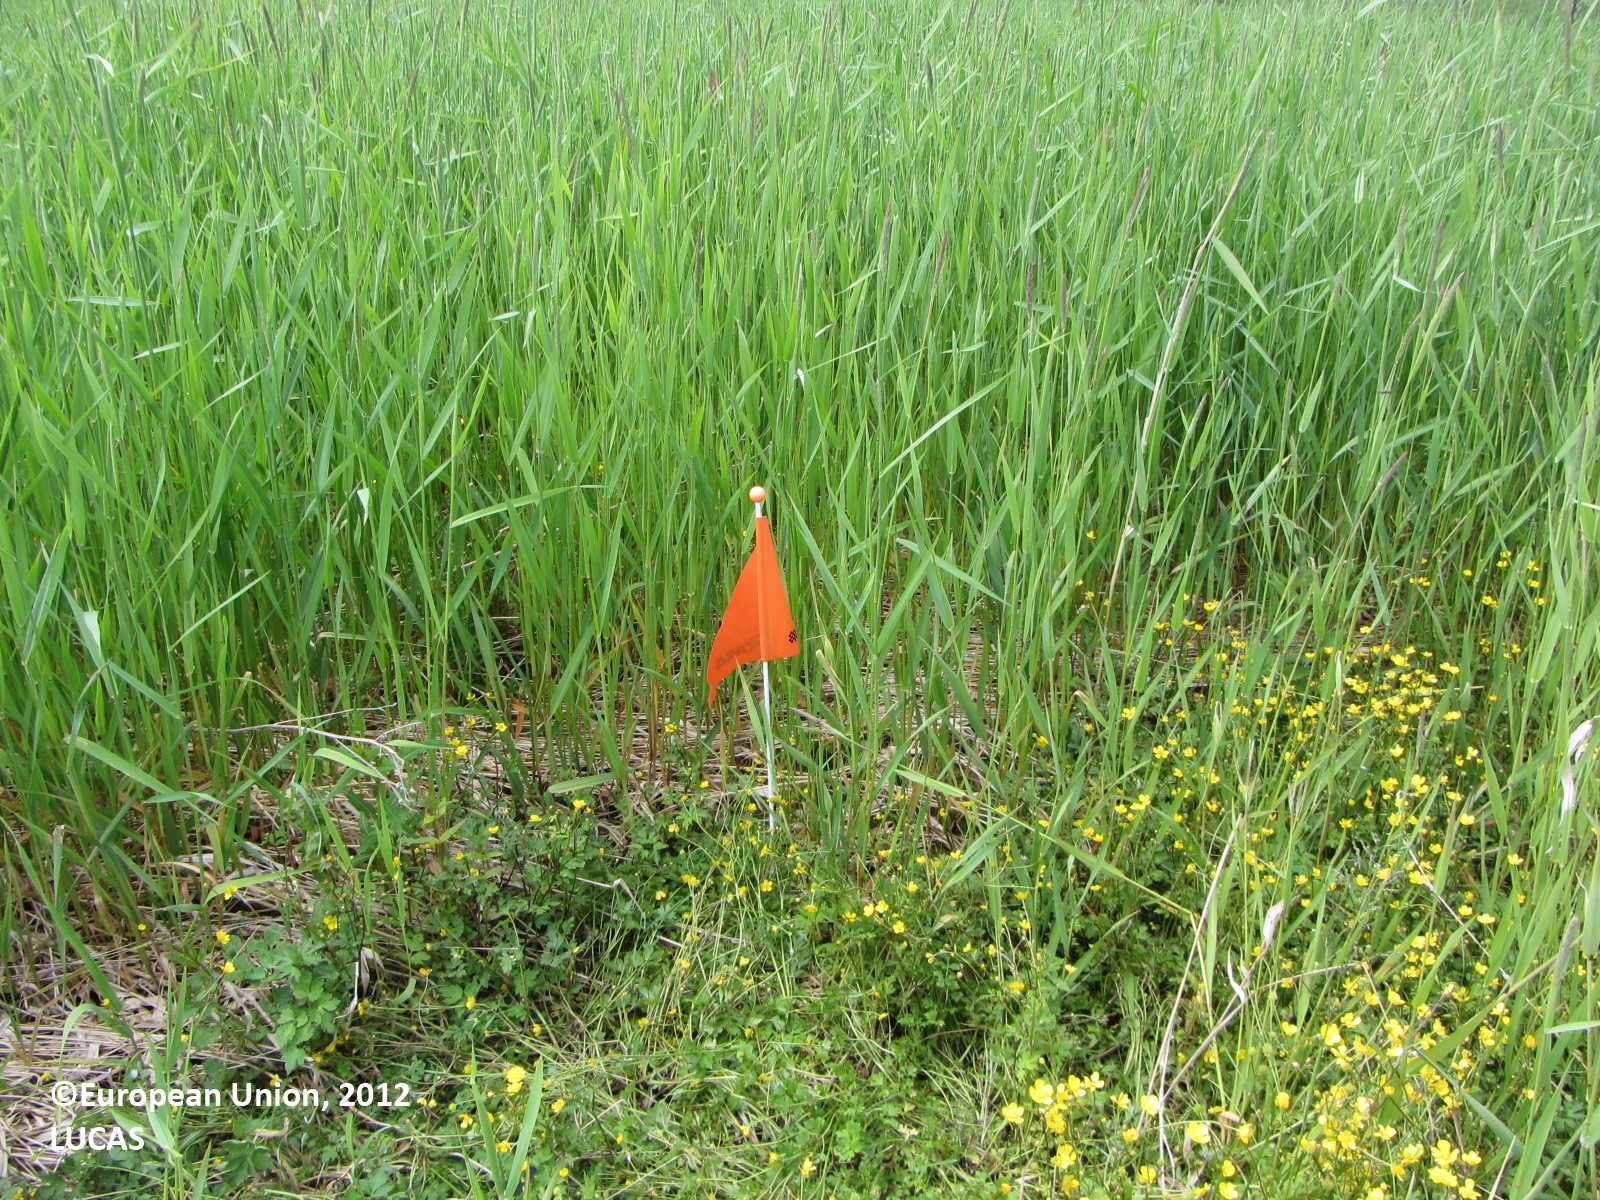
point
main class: Cropland
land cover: Temporary grasslands
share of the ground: > 75 %
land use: Agriculture (excluding fallow land and kitchen gardens)
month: July
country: FI
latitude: 62.8978
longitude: 25.0706
